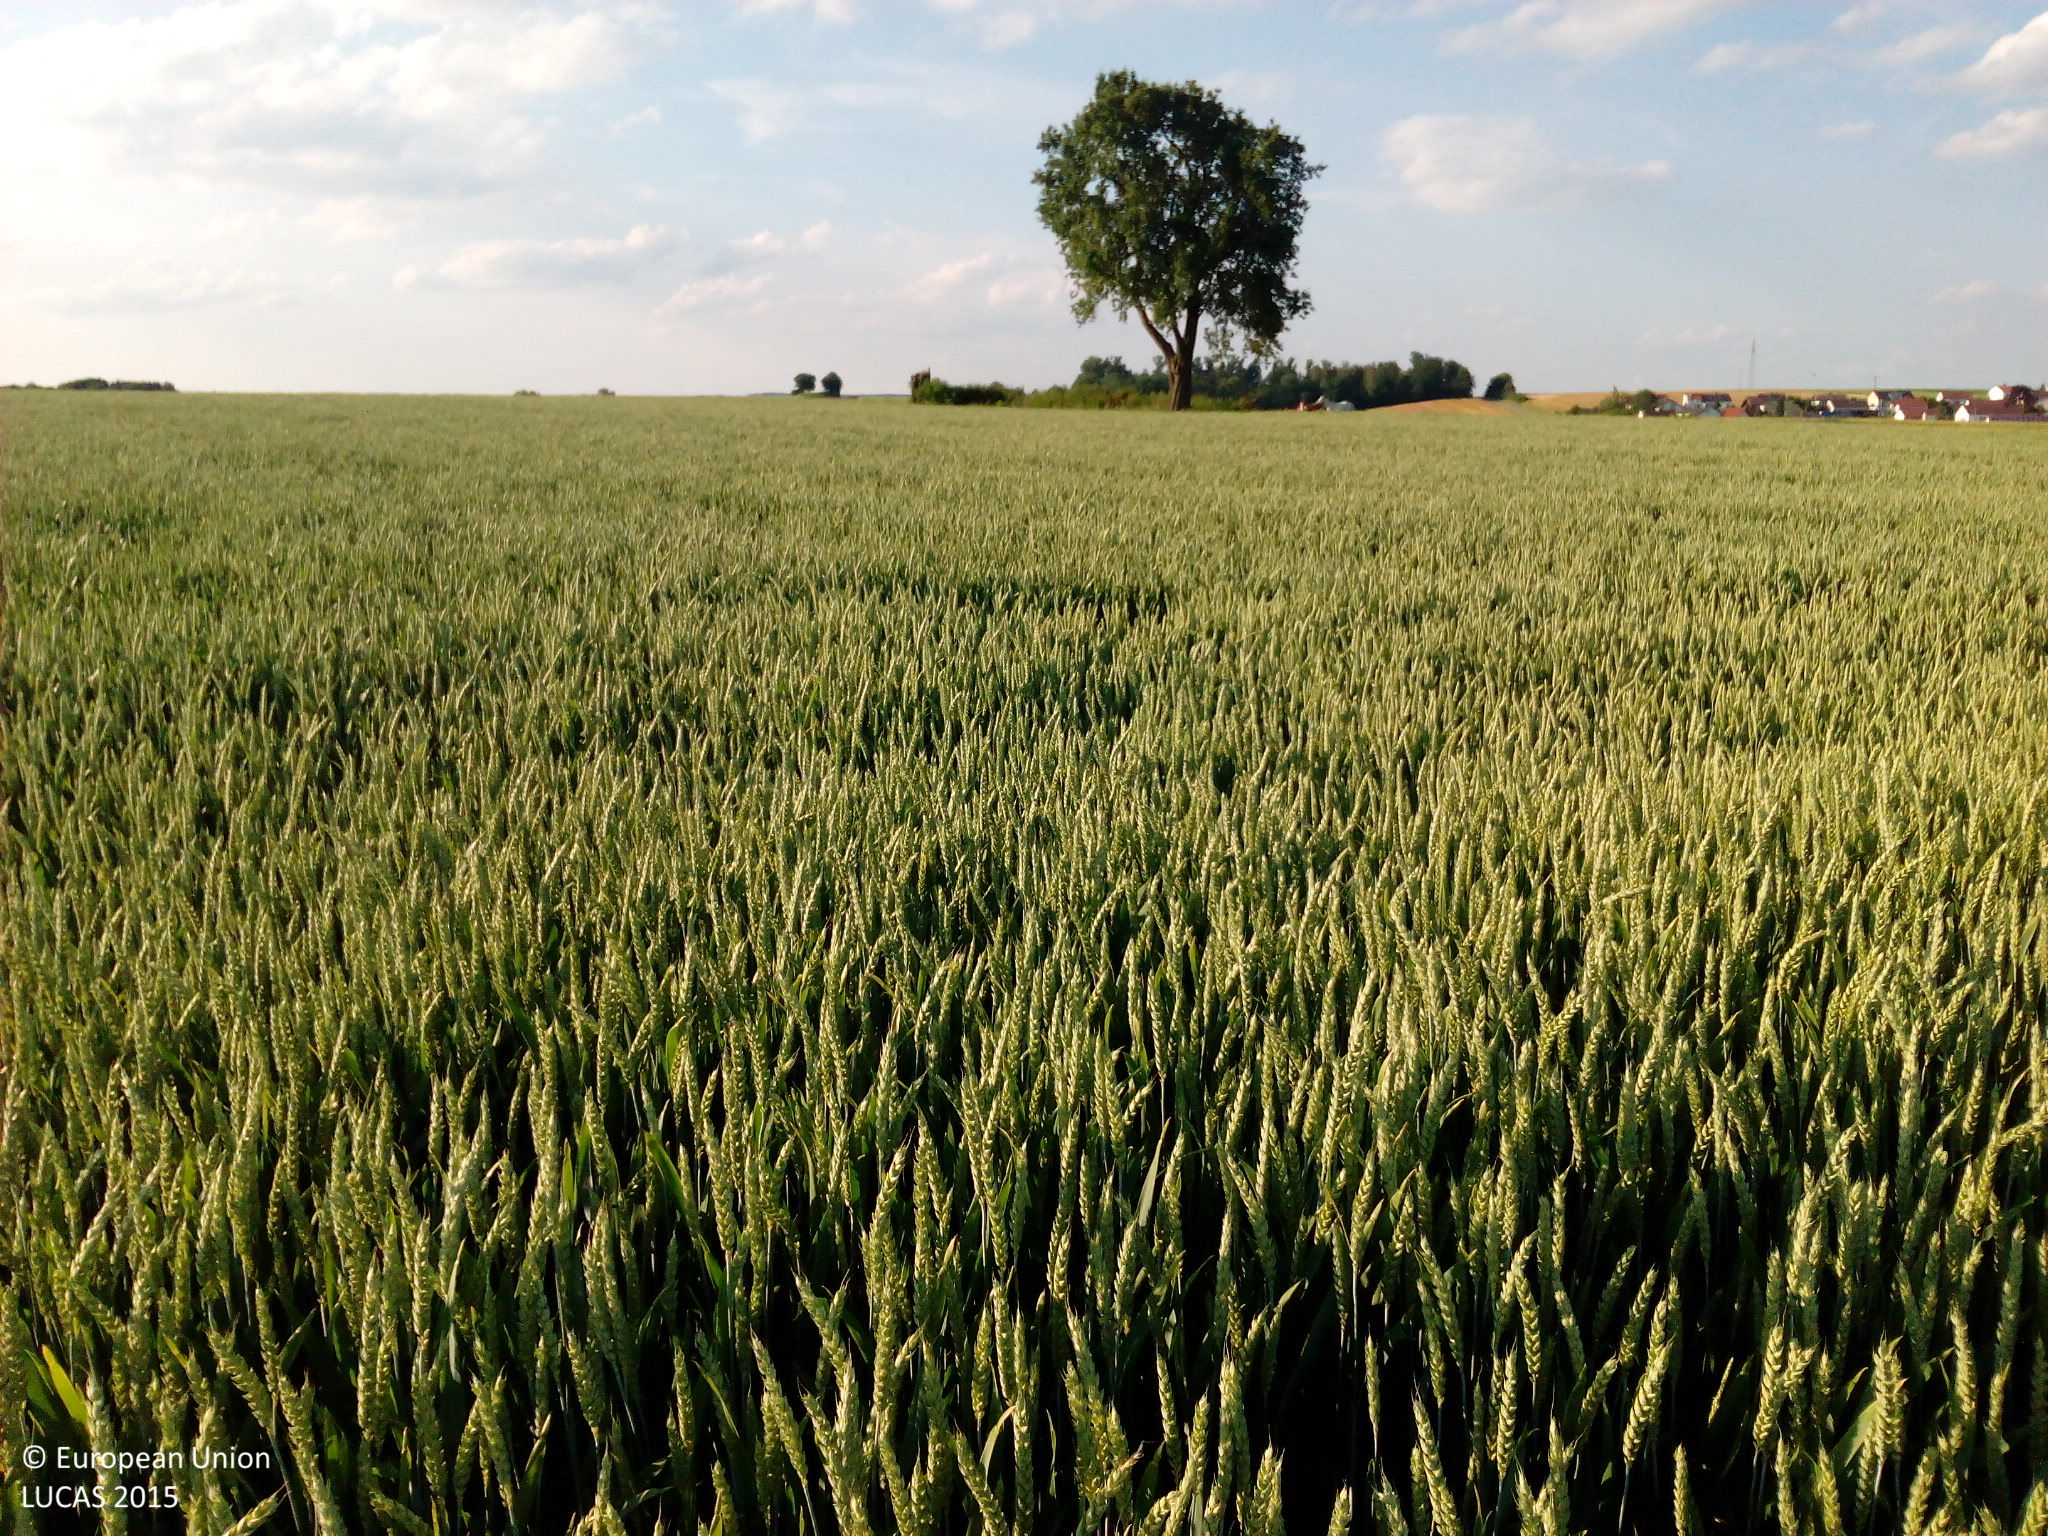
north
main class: Cropland
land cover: Common wheat
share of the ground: > 75 %
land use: Agriculture (excluding fallow land and kitchen gardens)
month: June
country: DE
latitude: 48.3134
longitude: 9.8518
